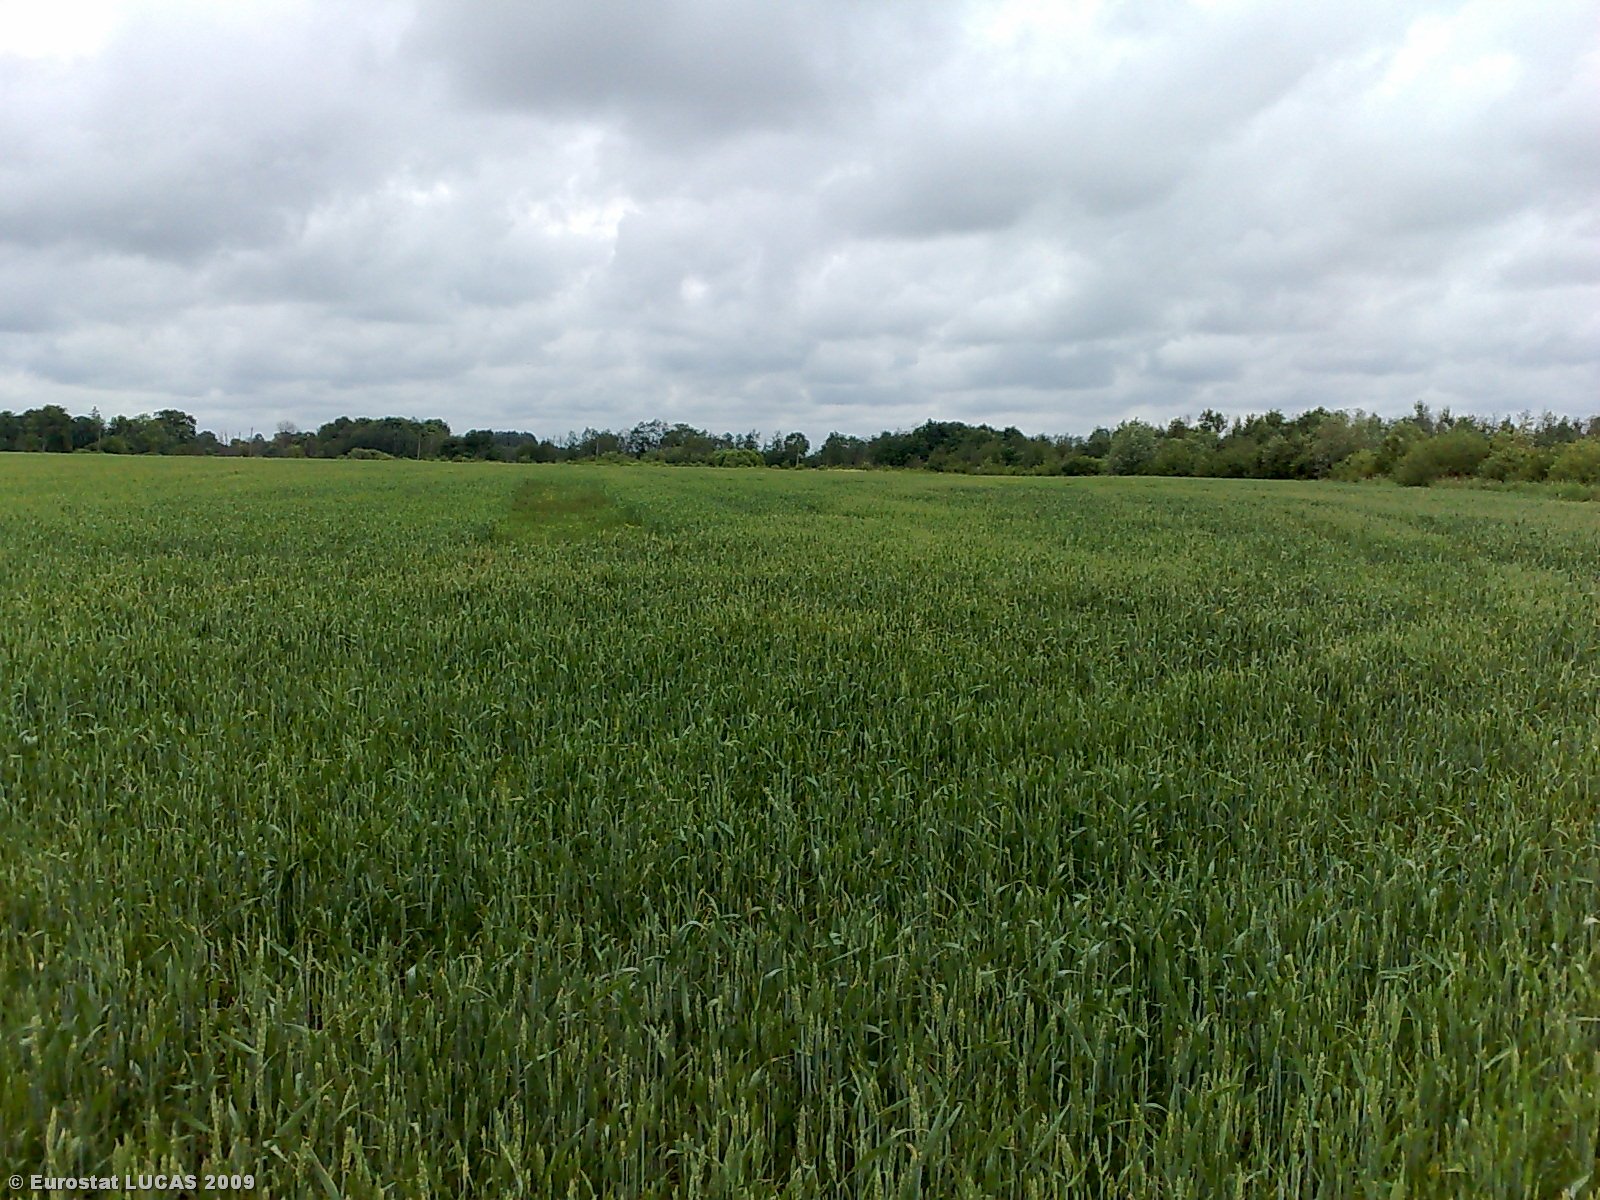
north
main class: Cropland
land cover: Common wheat
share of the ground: > 75 %
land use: Agriculture (excluding fallow land and kitchen gardens)
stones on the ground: < 10 %
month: June
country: LT
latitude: 56.0046
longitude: 23.9581
